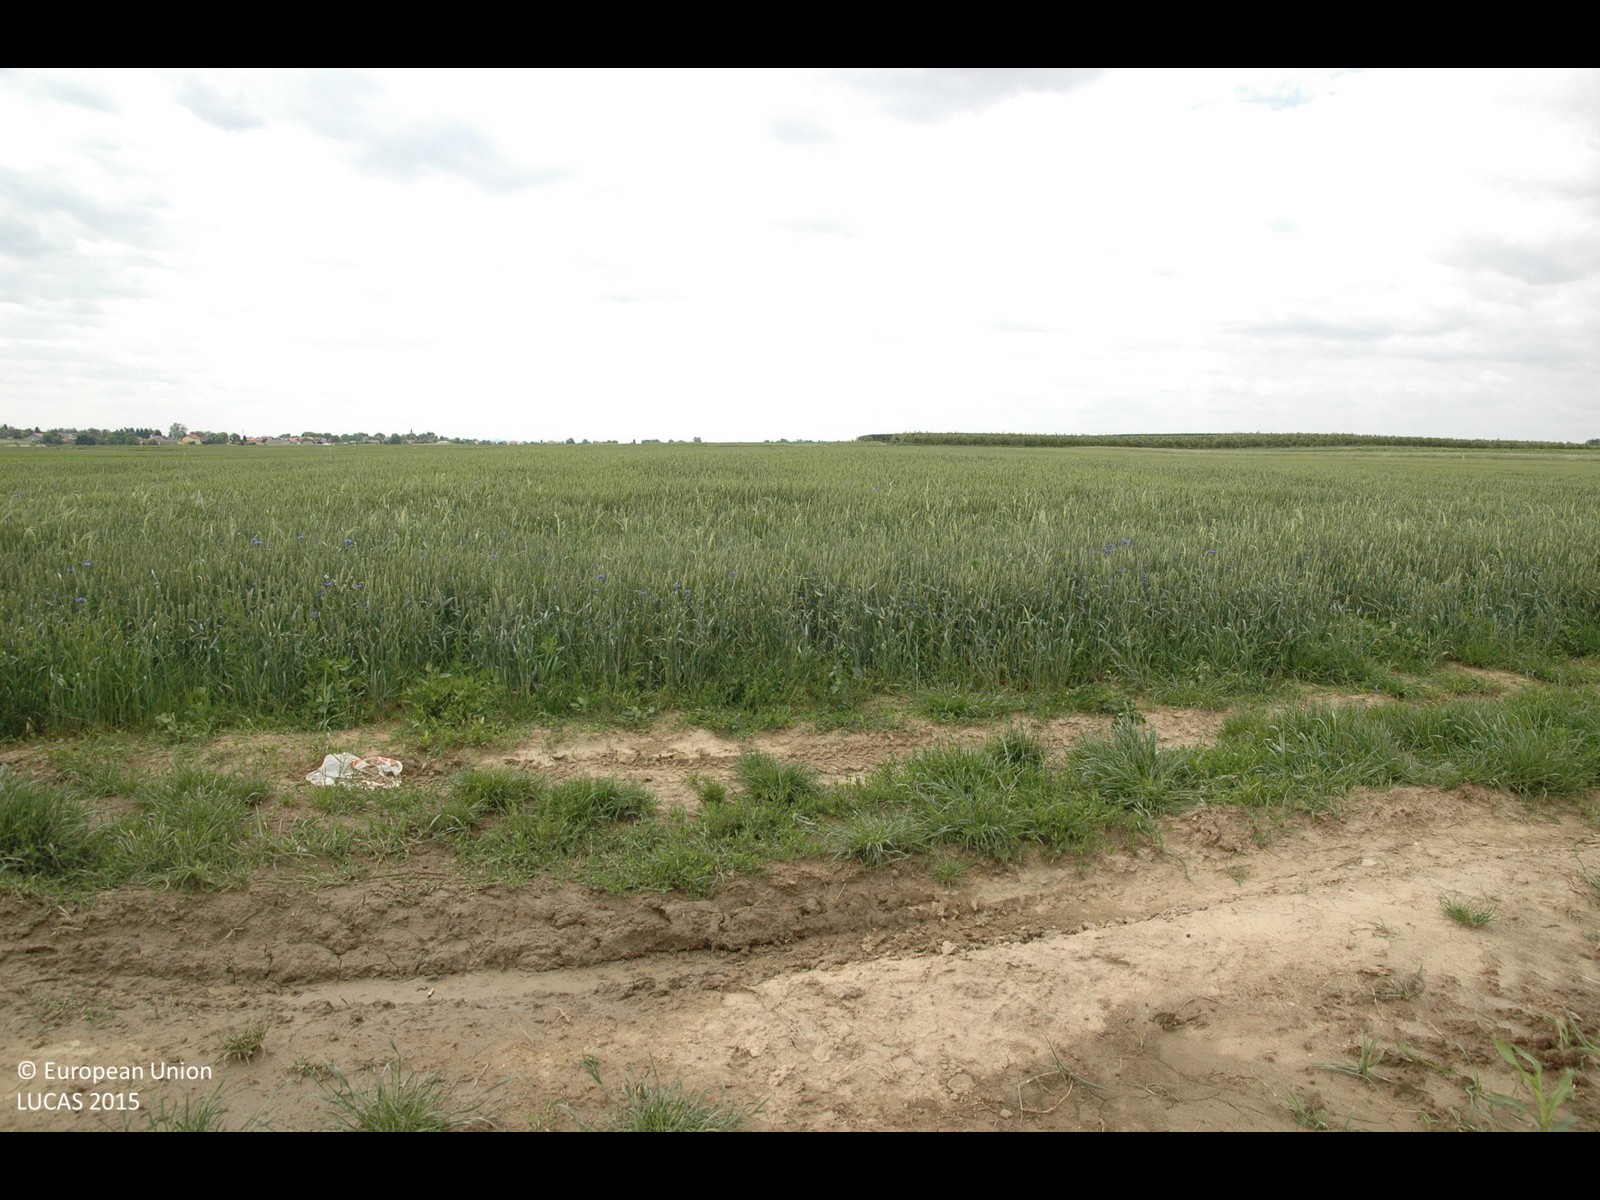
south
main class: Cropland
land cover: Maize
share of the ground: 10 - 25 %
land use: Agriculture (excluding fallow land and kitchen gardens)
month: May
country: HR
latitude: 46.4443
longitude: 16.4703
